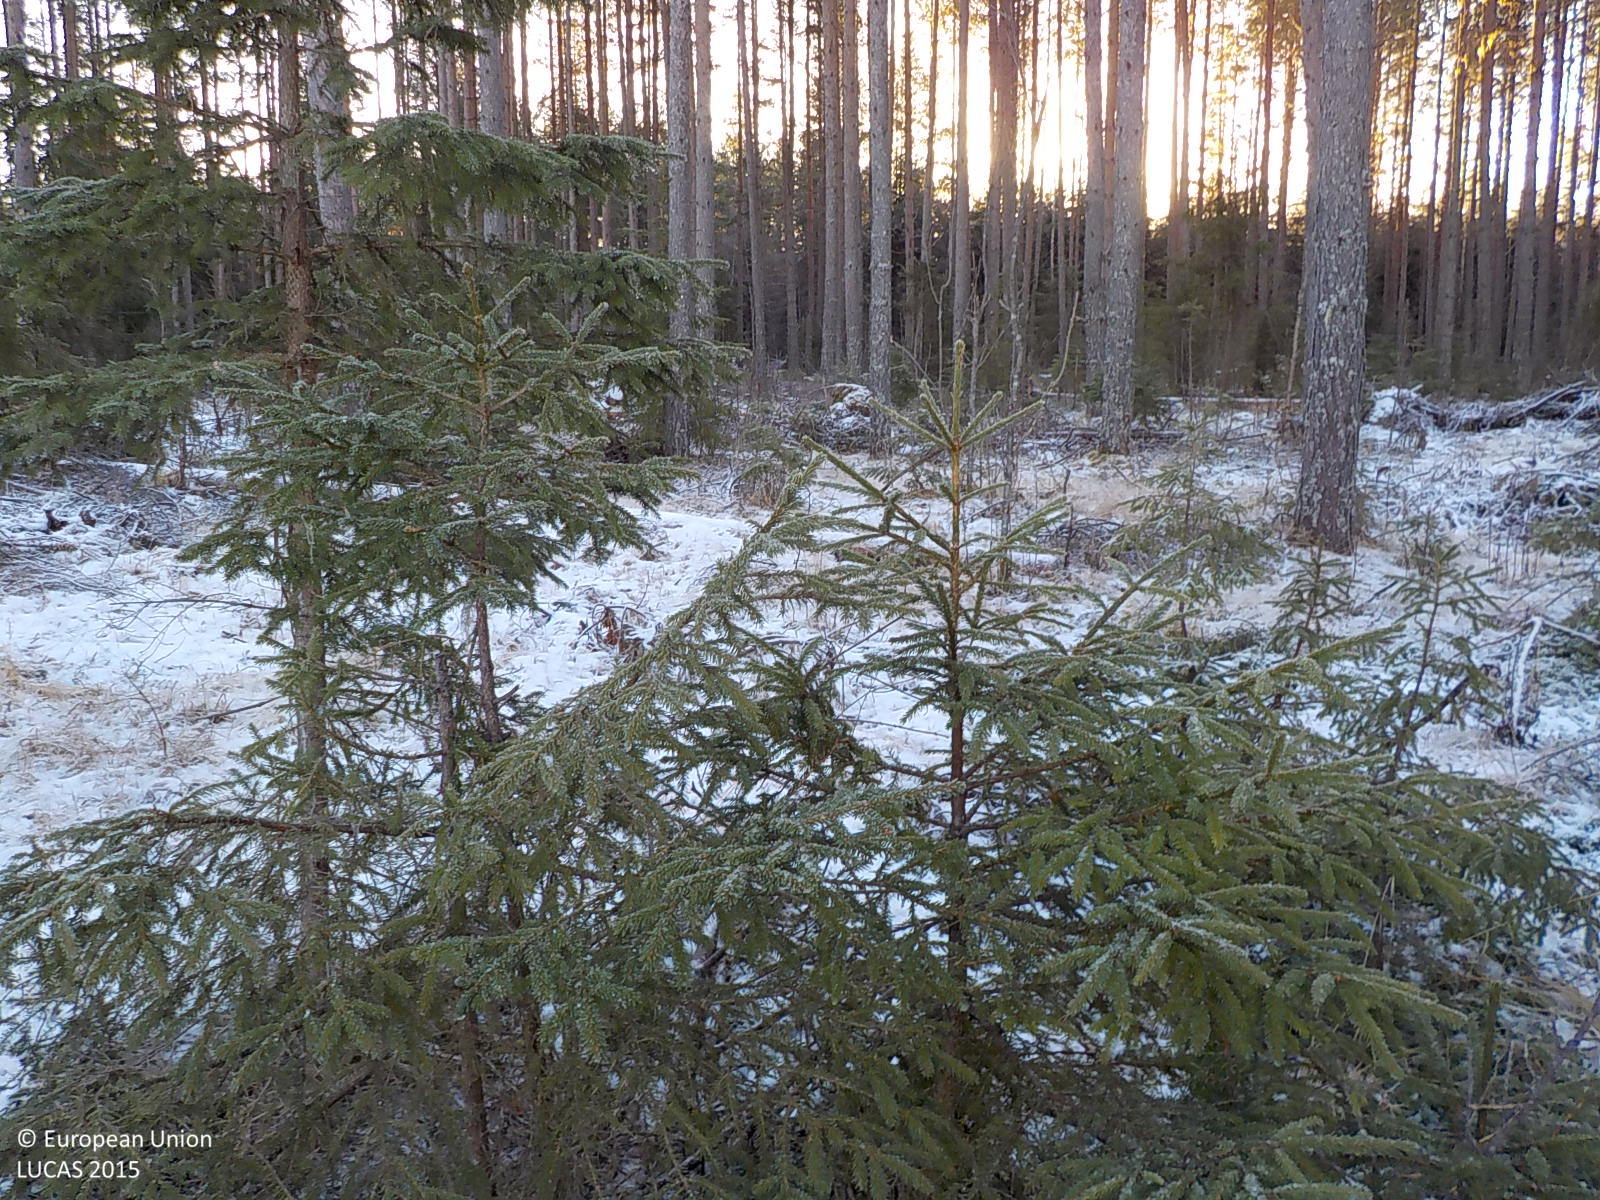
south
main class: Woodland
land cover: Pine dominated coniferous woodland
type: boreal forest
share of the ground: > 75 %
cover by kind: coniferous forest trees 75 %, shrubs 10 %, herbaceous plants 10 %, lichens and mosses 5 %
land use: Forestry
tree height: > 5 m
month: December
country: SE
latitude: 63.2981
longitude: 16.6572
